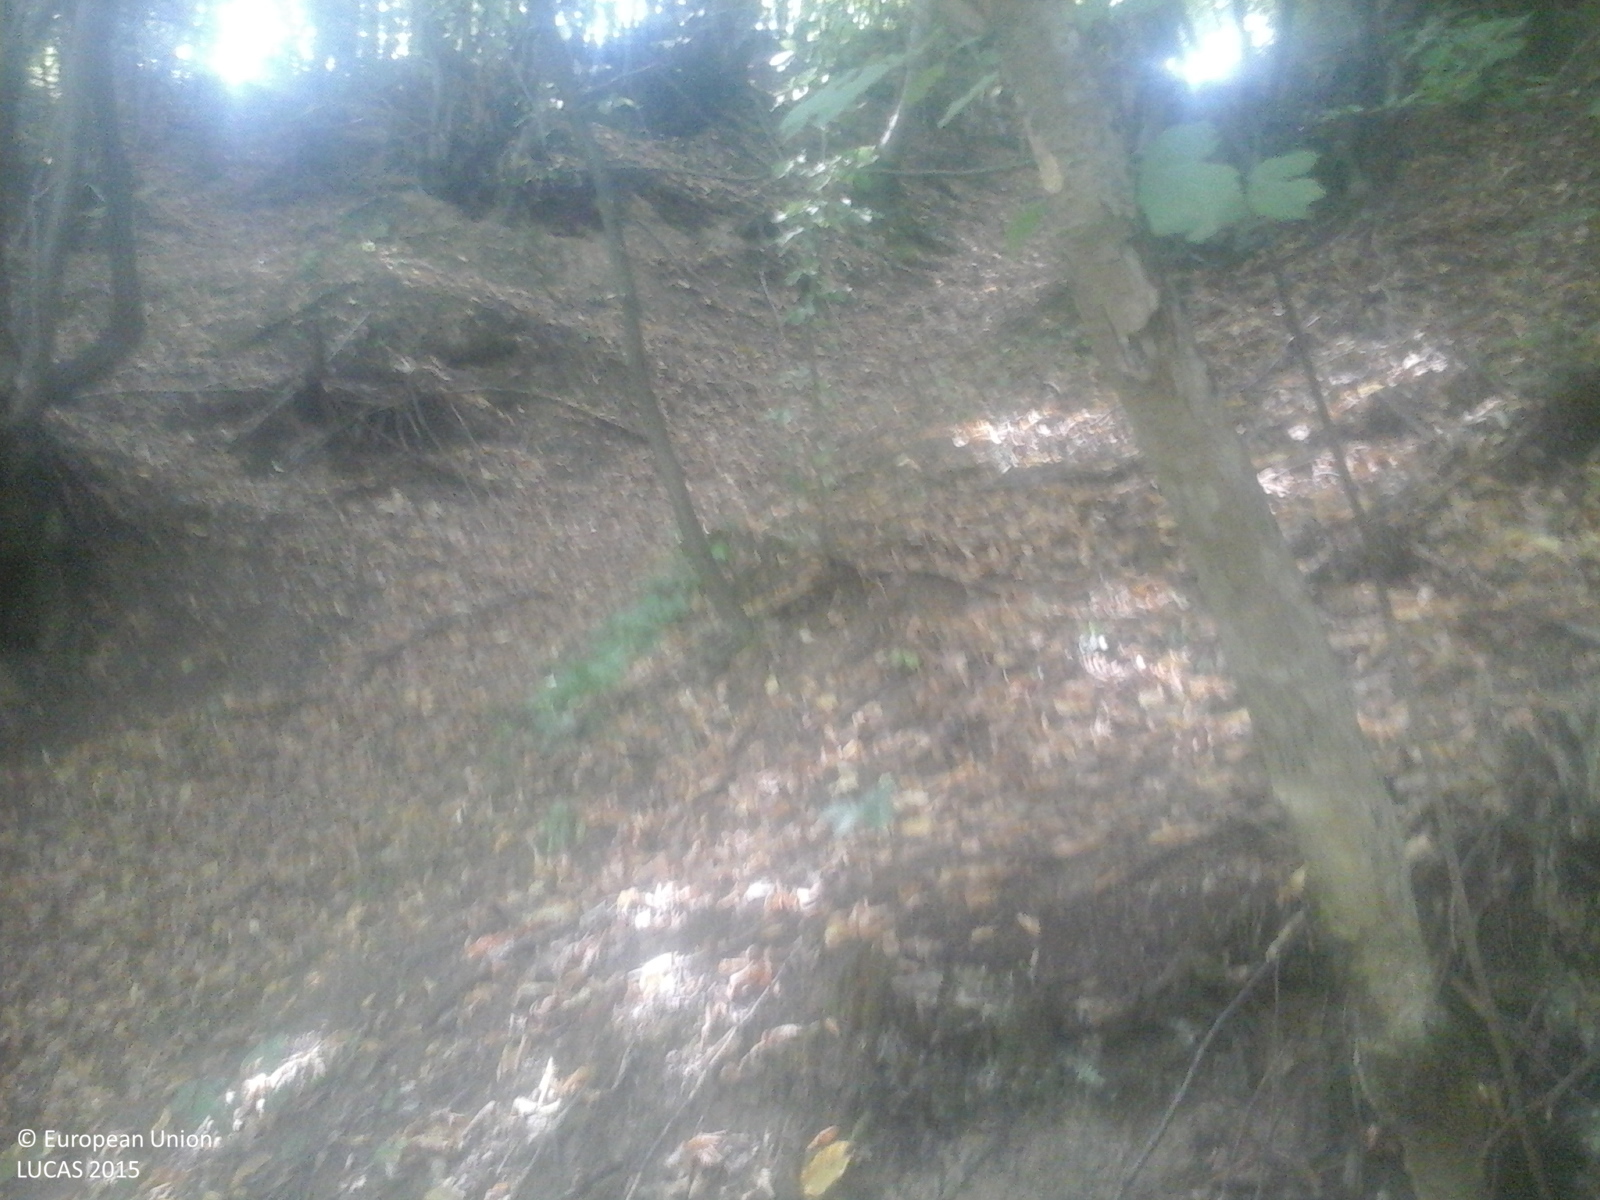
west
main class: Woodland
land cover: Broadleaved woodland
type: beech forest
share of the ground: > 75 %
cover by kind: broadleaved forest trees 100 %
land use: Forestry
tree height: > 5 m
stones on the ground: < 10 %
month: September
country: RO
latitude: 47.7112
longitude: 24.3941
